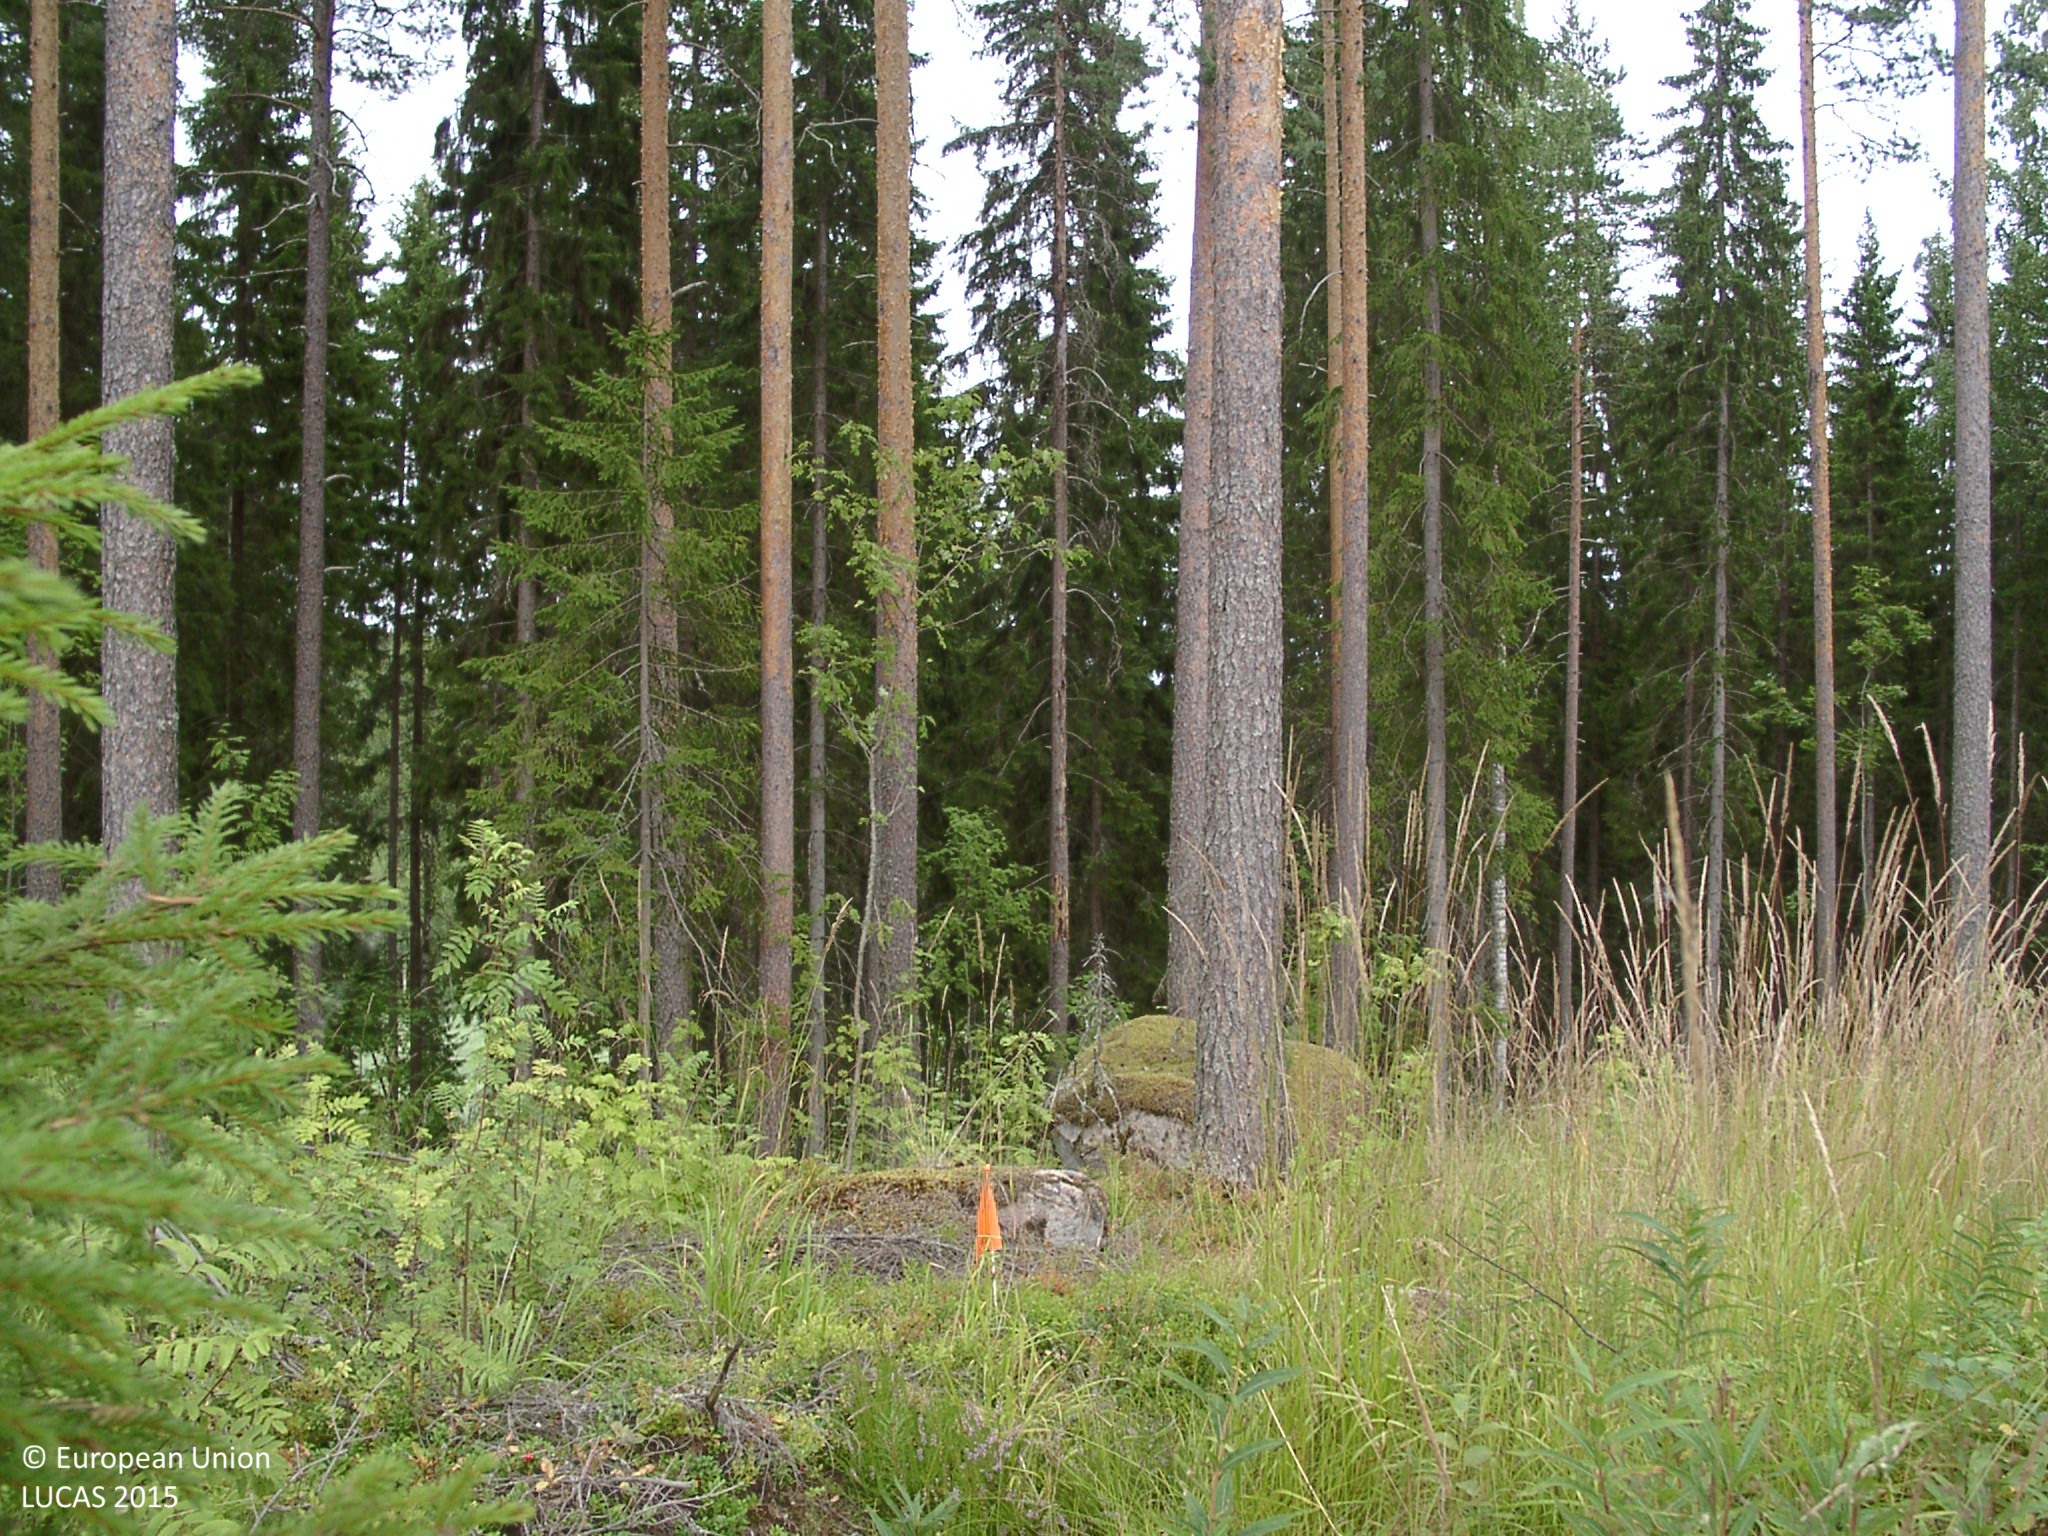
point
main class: Woodland
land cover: Other coniferous woodland
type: boreal forest
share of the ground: 50 - 75 %
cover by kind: coniferous forest trees 55 %, shrubs 15 %, broadleaved forest trees 10 %, herbaceous plants 10 %, lichens and mosses 10 %
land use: Forestry
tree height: > 5 m
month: August
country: FI
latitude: 61.7786
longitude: 25.3756
